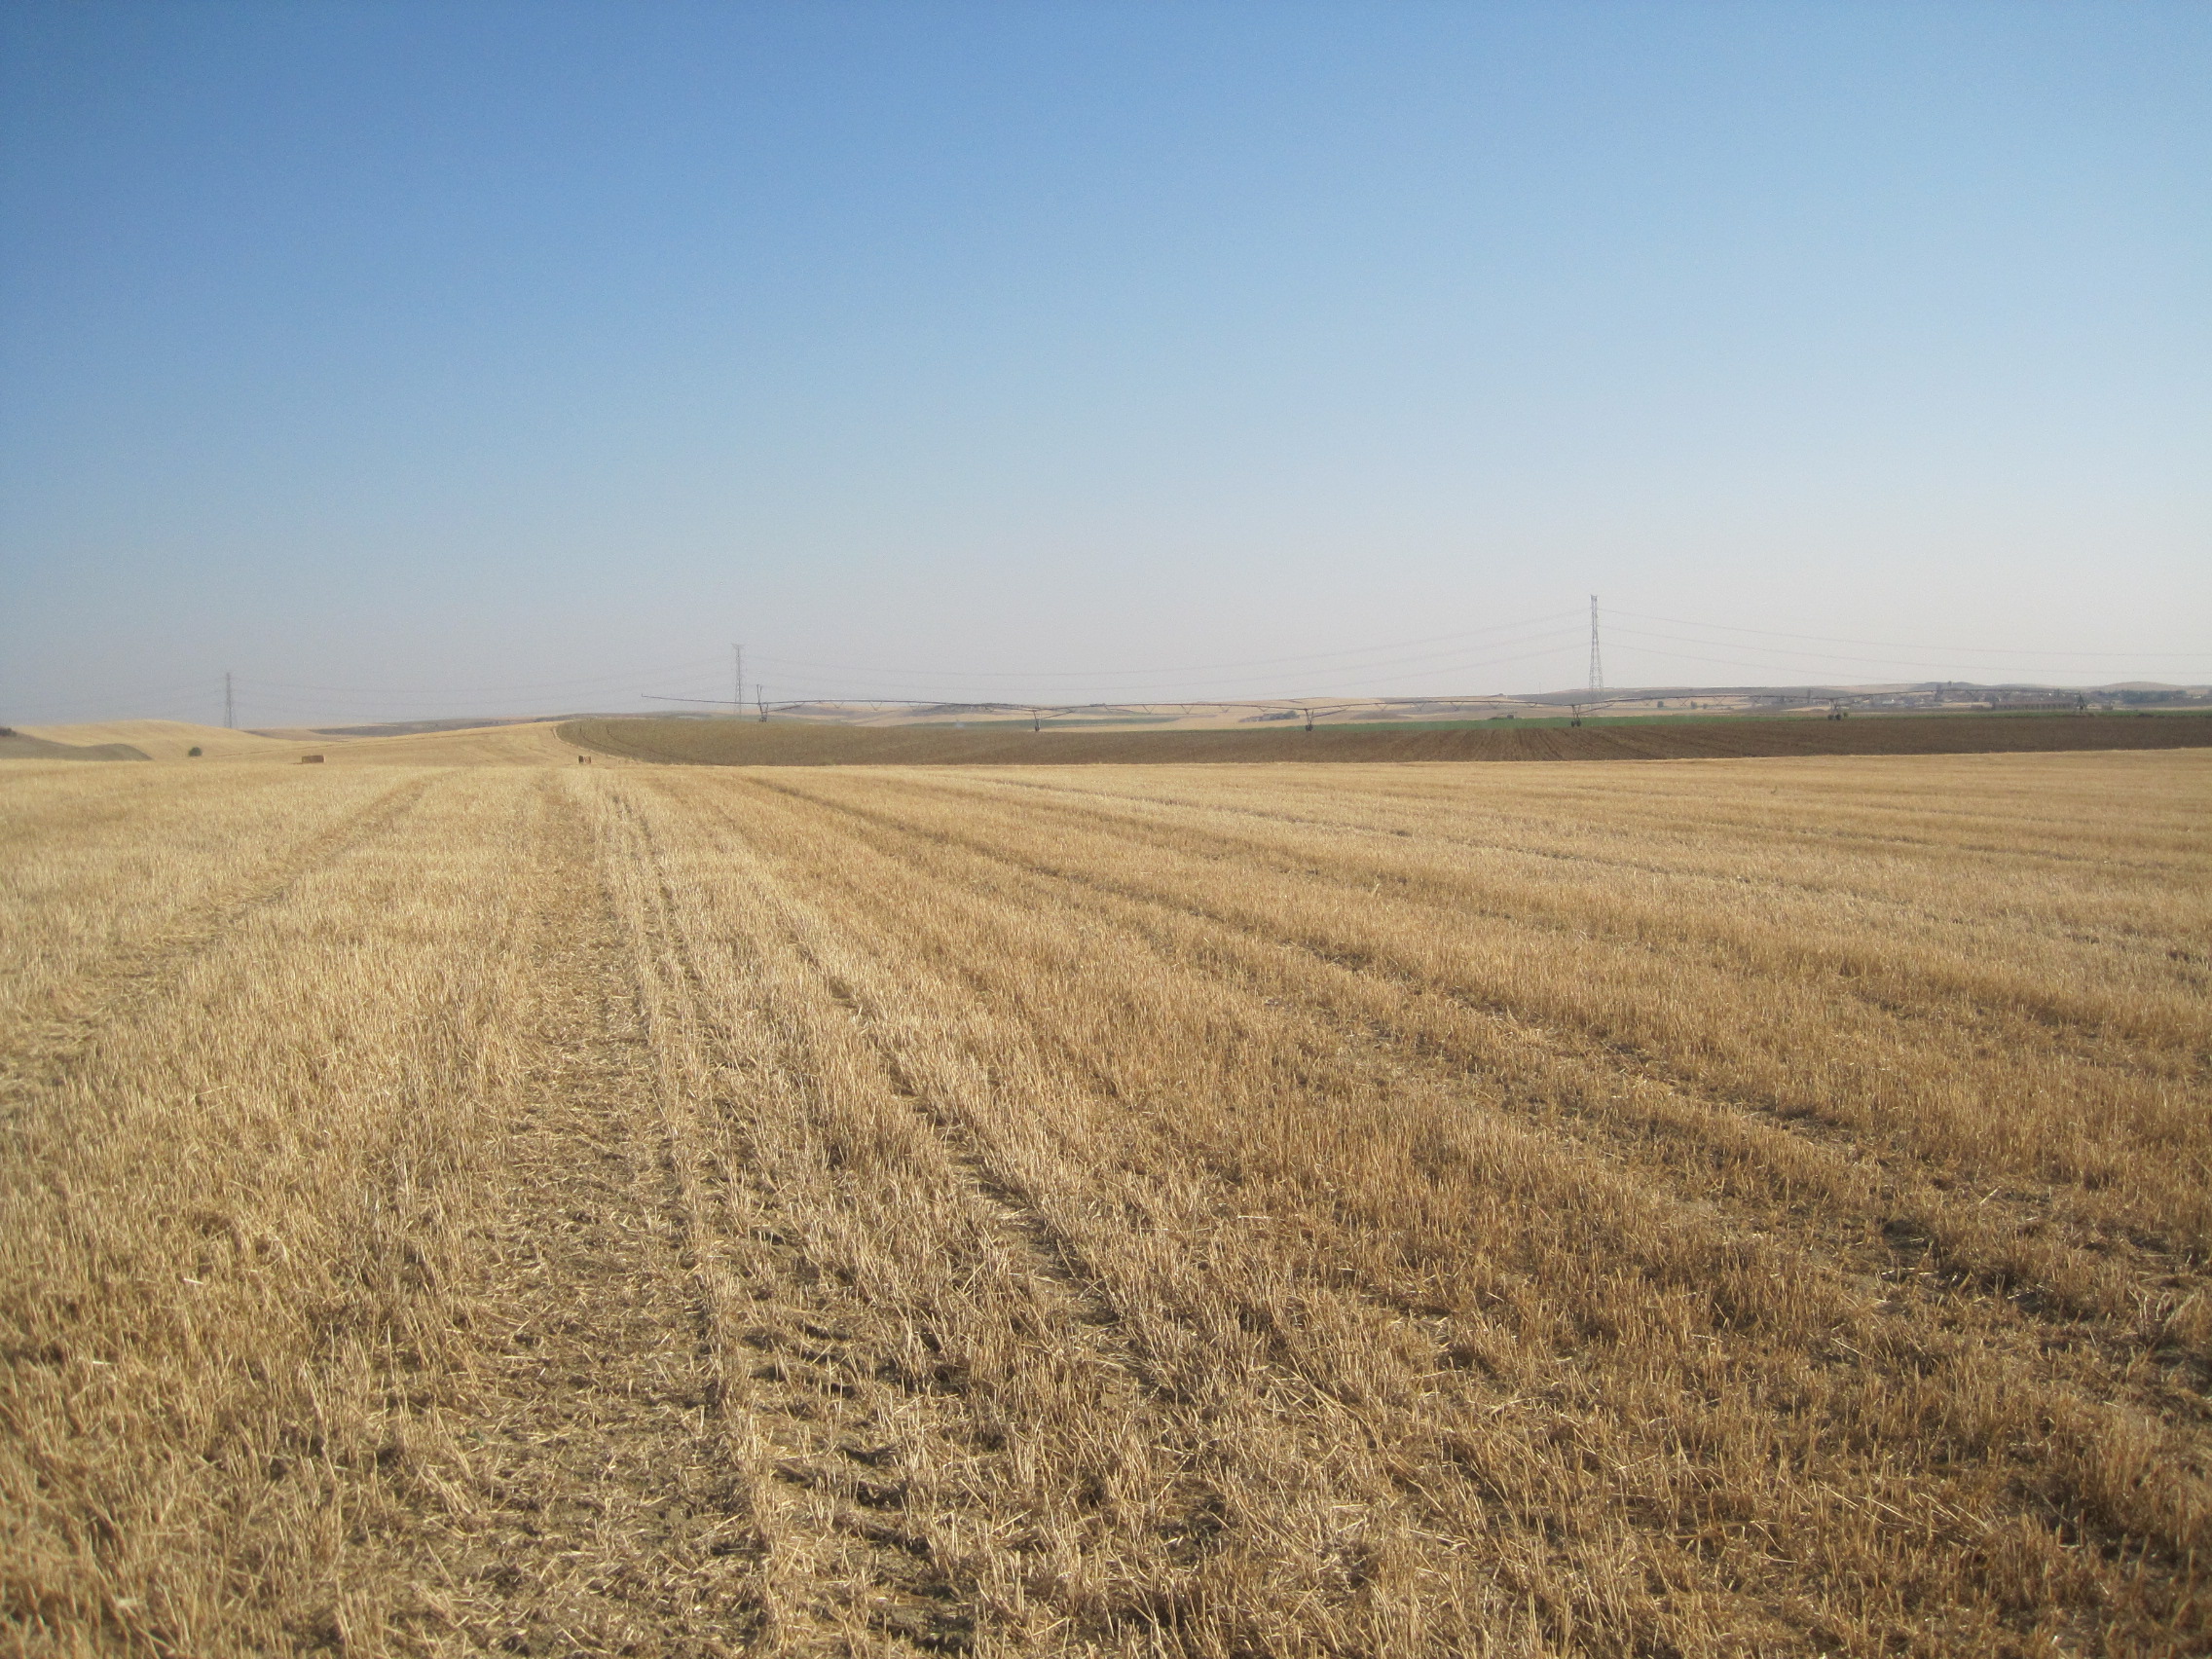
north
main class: Cropland
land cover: Barley
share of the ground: < 10 %
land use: Agriculture (excluding fallow land and kitchen gardens)
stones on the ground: < 10 %
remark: Harvested field
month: July
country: ES
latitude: 41.6000
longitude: -5.3778
